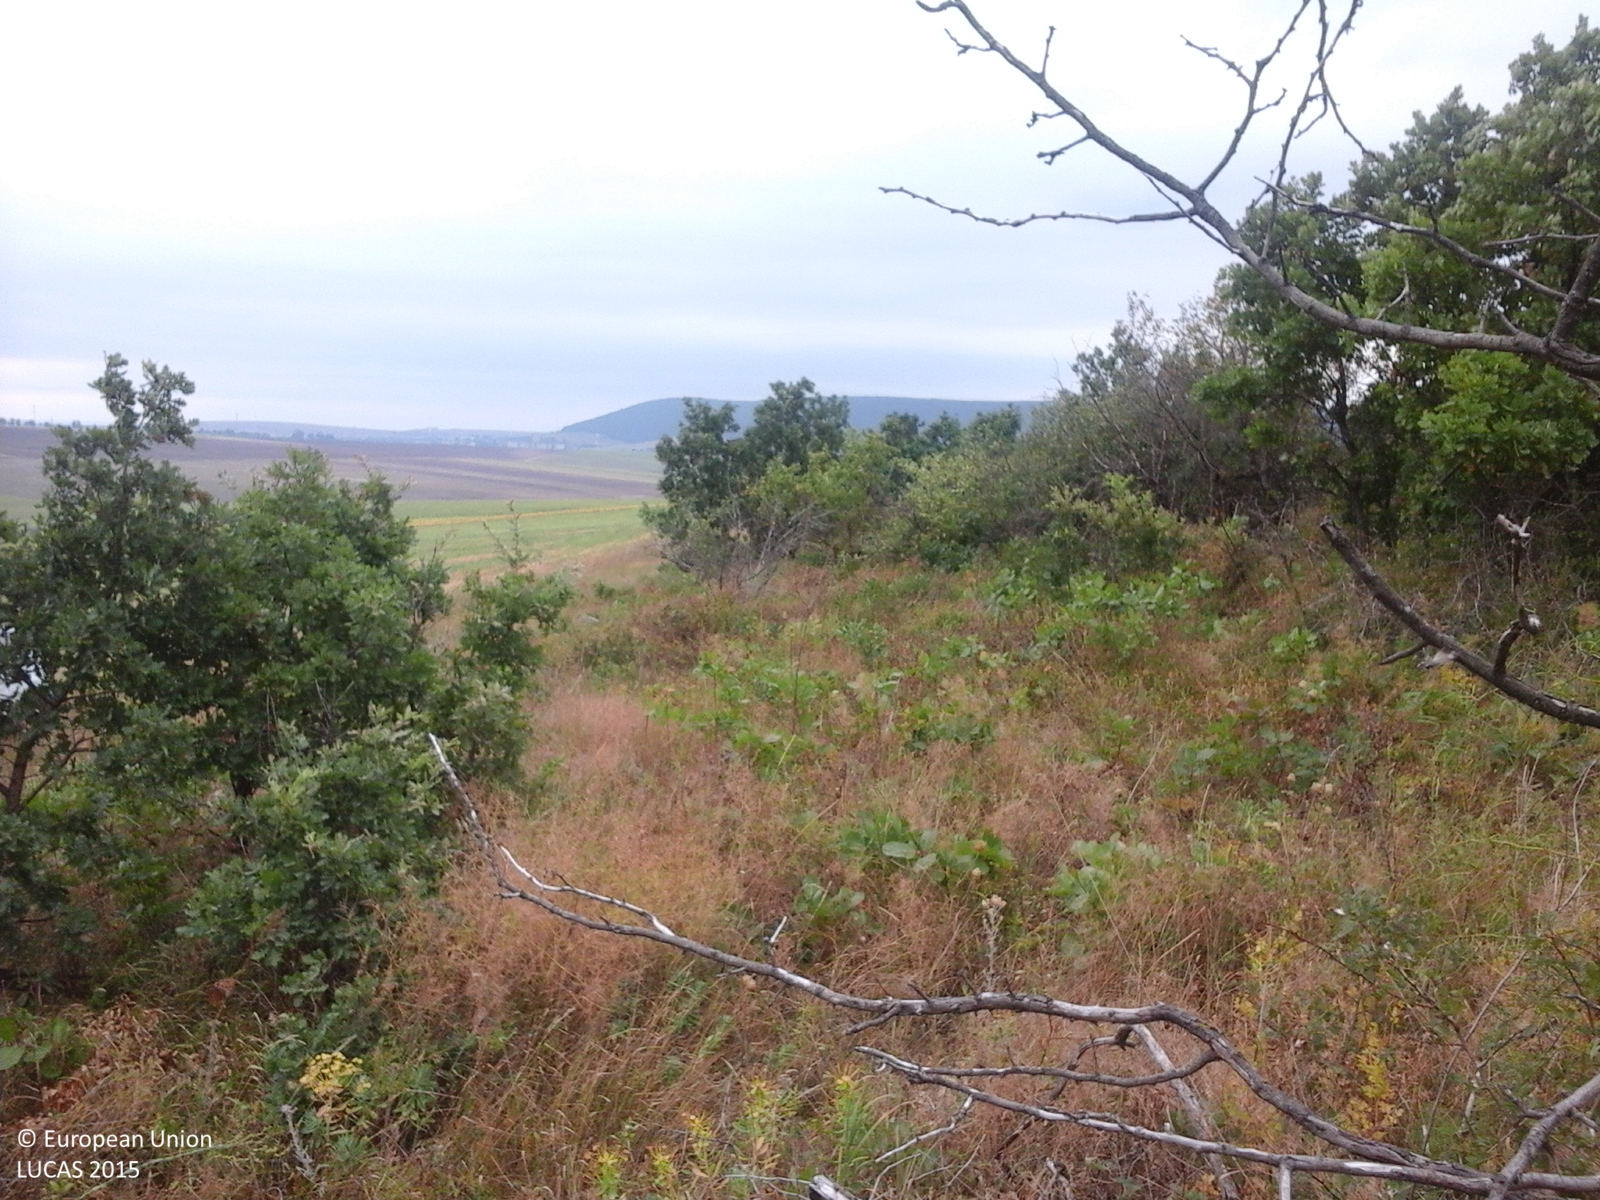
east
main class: Shrubland
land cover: Shrubland with sparse tree cover
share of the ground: > 75 %
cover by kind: shrubs 75 %, herbaceous plants 20 %, broadleaved forest trees 5 %
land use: Agriculture (excluding fallow land and kitchen gardens)
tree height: > 5 m
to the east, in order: Shrubland with sparse tree cover; Common wheat
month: August
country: RO
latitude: 44.8935
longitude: 28.6581
